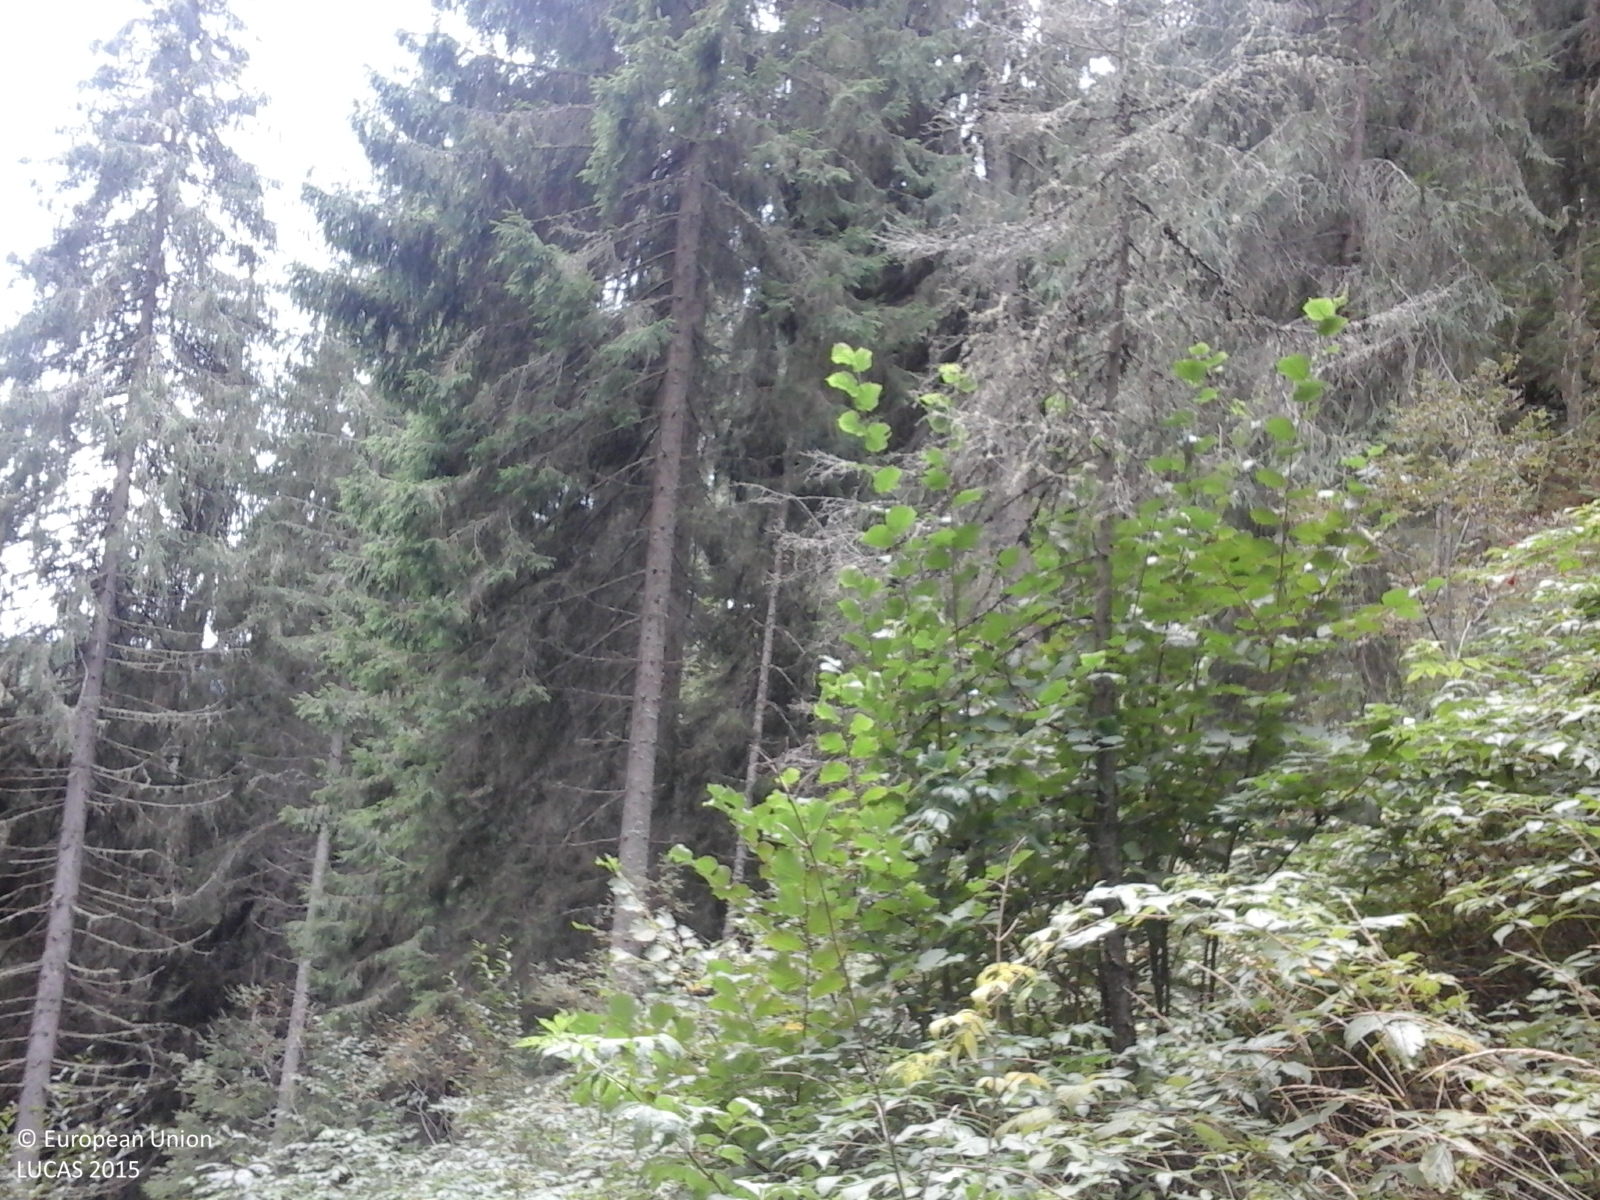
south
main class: Woodland
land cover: Spruce dominated coniferous woodland
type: alpine coniferous forest
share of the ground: > 75 %
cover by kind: coniferous forest trees 75 %, shrubs 10 %, herbaceous plants 10 %, broadleaved forest trees 5 %
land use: Forestry
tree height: > 5 m
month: September
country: RO
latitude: 46.6677
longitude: 22.9867
